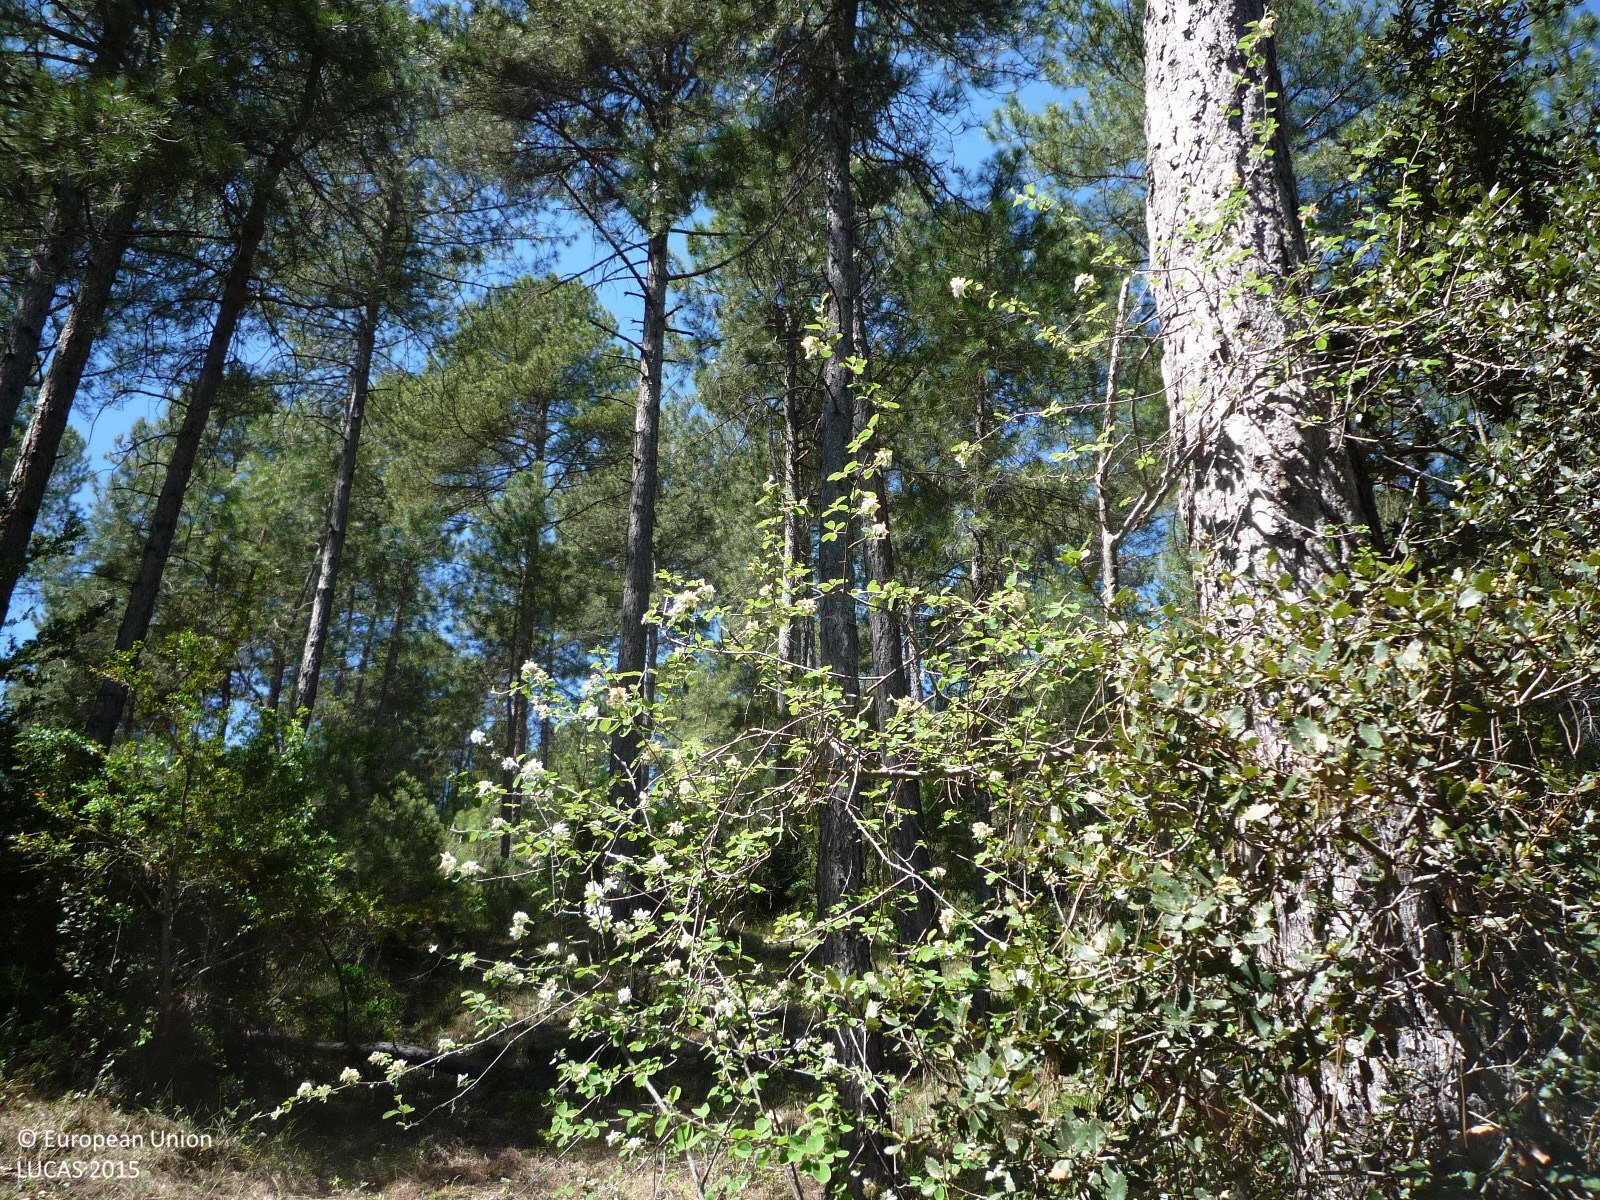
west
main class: Woodland
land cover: Pine dominated coniferous woodland
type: coniferous forest of the mediterranean region
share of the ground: > 75 %
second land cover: Spontaneously vegetated surfaces
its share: 25 - 50 %
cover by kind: coniferous forest trees 90 %, shrubs 10 %
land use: Forestry
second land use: Agriculture (excluding fallow land and kitchen gardens)
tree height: > 5 m
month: May
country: ES
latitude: 41.8005
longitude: 1.6497
